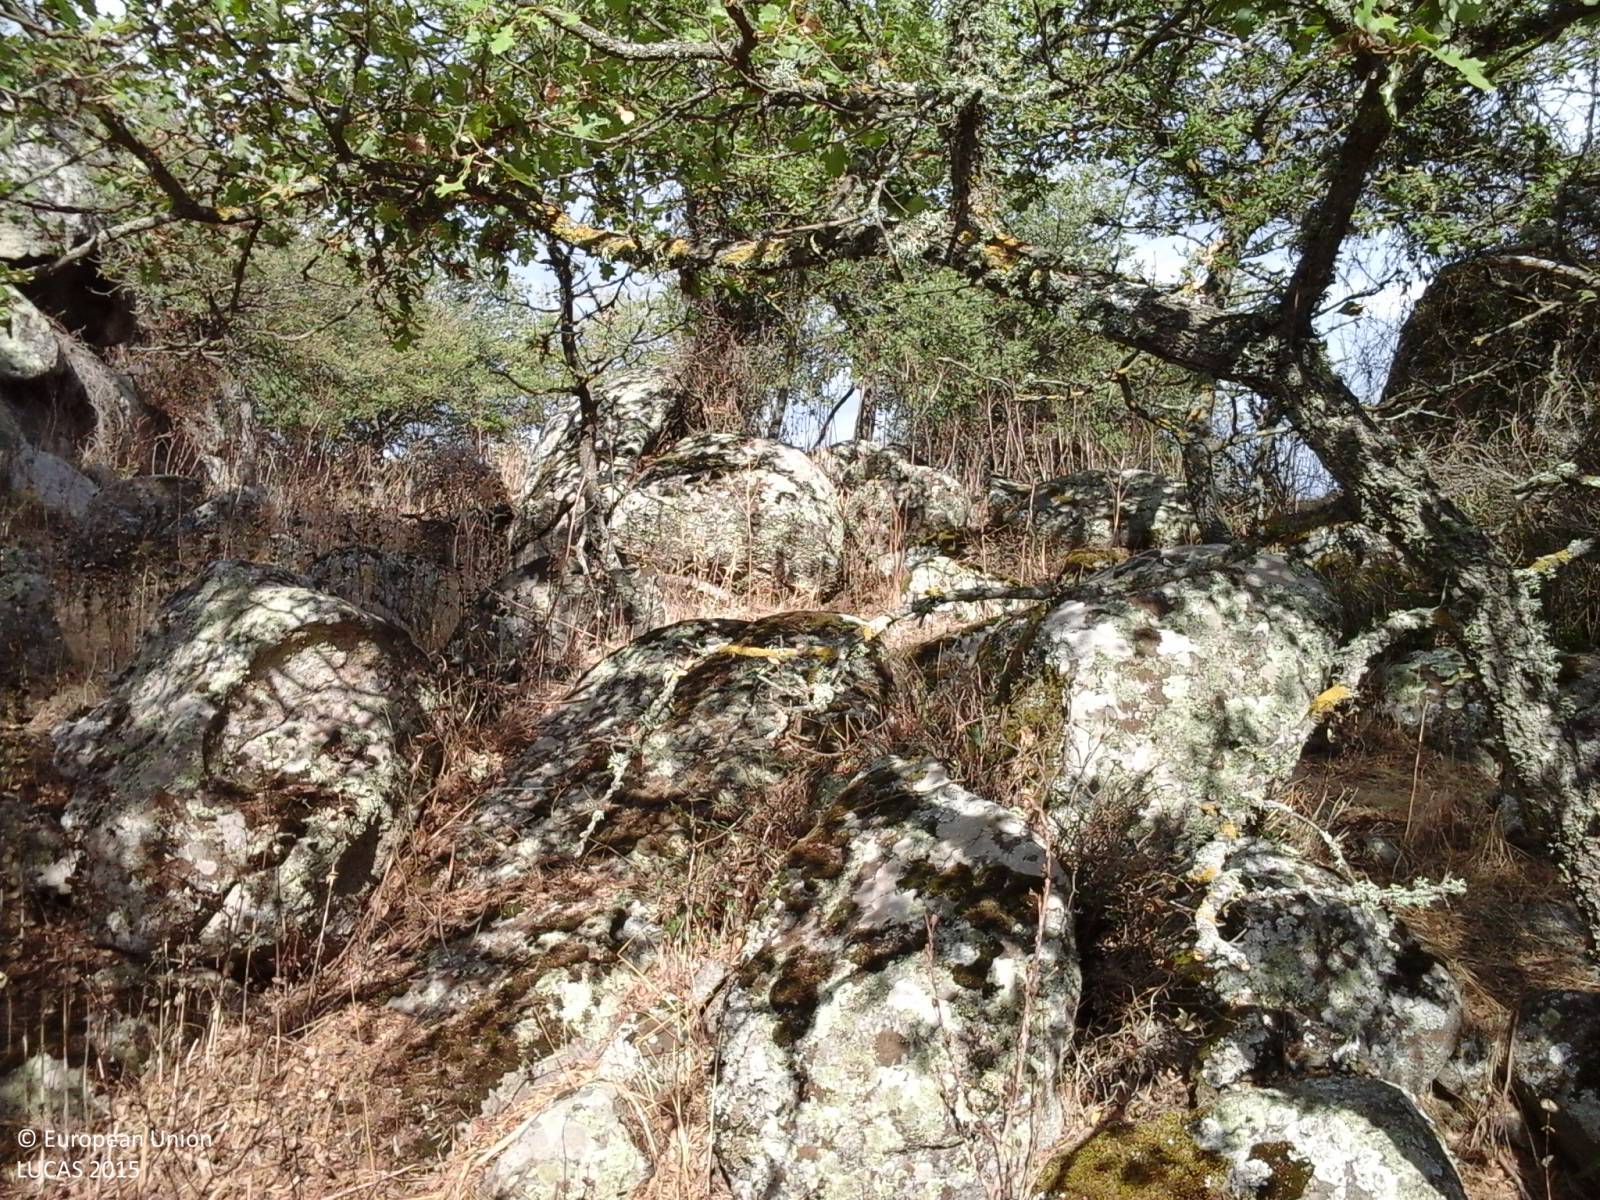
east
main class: Woodland
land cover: Broadleaved woodland
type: broadleaved evergreen forest
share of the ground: > 75 %
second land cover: Grassland without tree/shrub cover
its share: > 75 %
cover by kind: herbaceous plants 55 %, shrubs 35 %, broadleaved forest trees 10 %
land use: Forestry
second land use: Agriculture (excluding fallow land and kitchen gardens)
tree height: > 5 m
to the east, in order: Broadleaved woodland; Grassland without tree/shrub cover; Electric lines; Grassland with sparse tree/shrub cover; Tracks; Grassland with sparse tree/shrub cover; Fences; Grassland with sparse tree/shrub cover; Electric lines; Grassland with sparse tree/shrub cover; Dry stone walls; Fences; Abandoned hedges; Grassland without tree/shrub cover
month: August
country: IT
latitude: 40.5353
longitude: 9.1660
